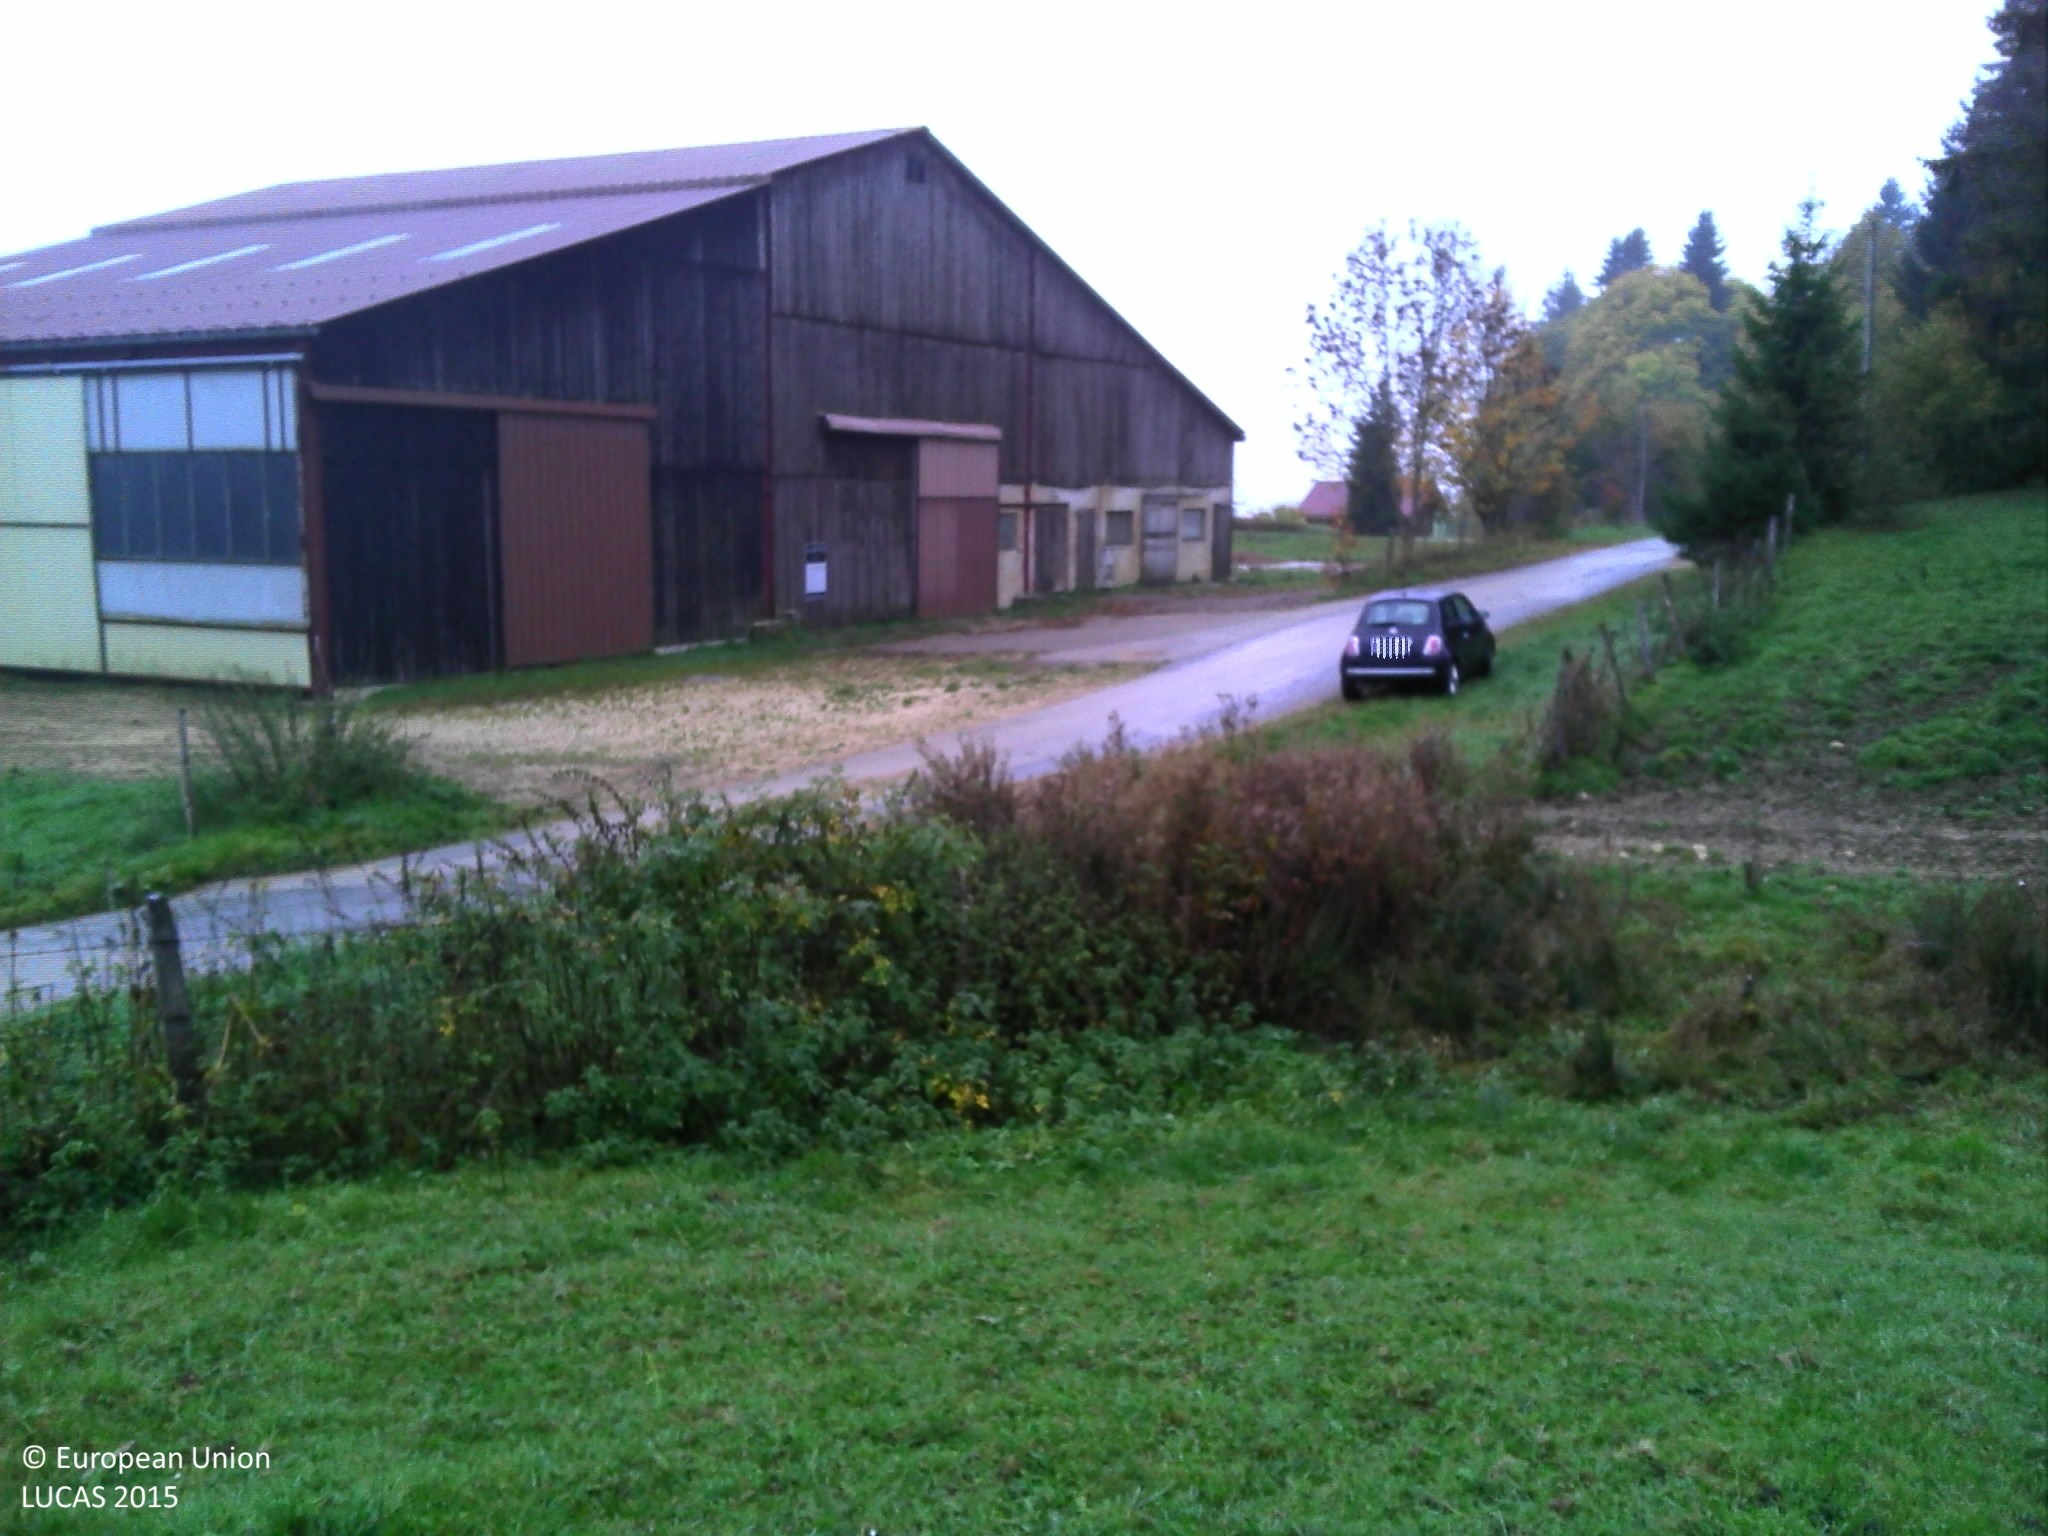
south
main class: Grassland
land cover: Grassland without tree/shrub cover
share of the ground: > 75 %
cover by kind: herbaceous plants 100 %
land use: Agriculture (excluding fallow land and kitchen gardens)
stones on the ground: < 10 %
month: October
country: FR
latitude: 46.8098
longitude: 6.2939
